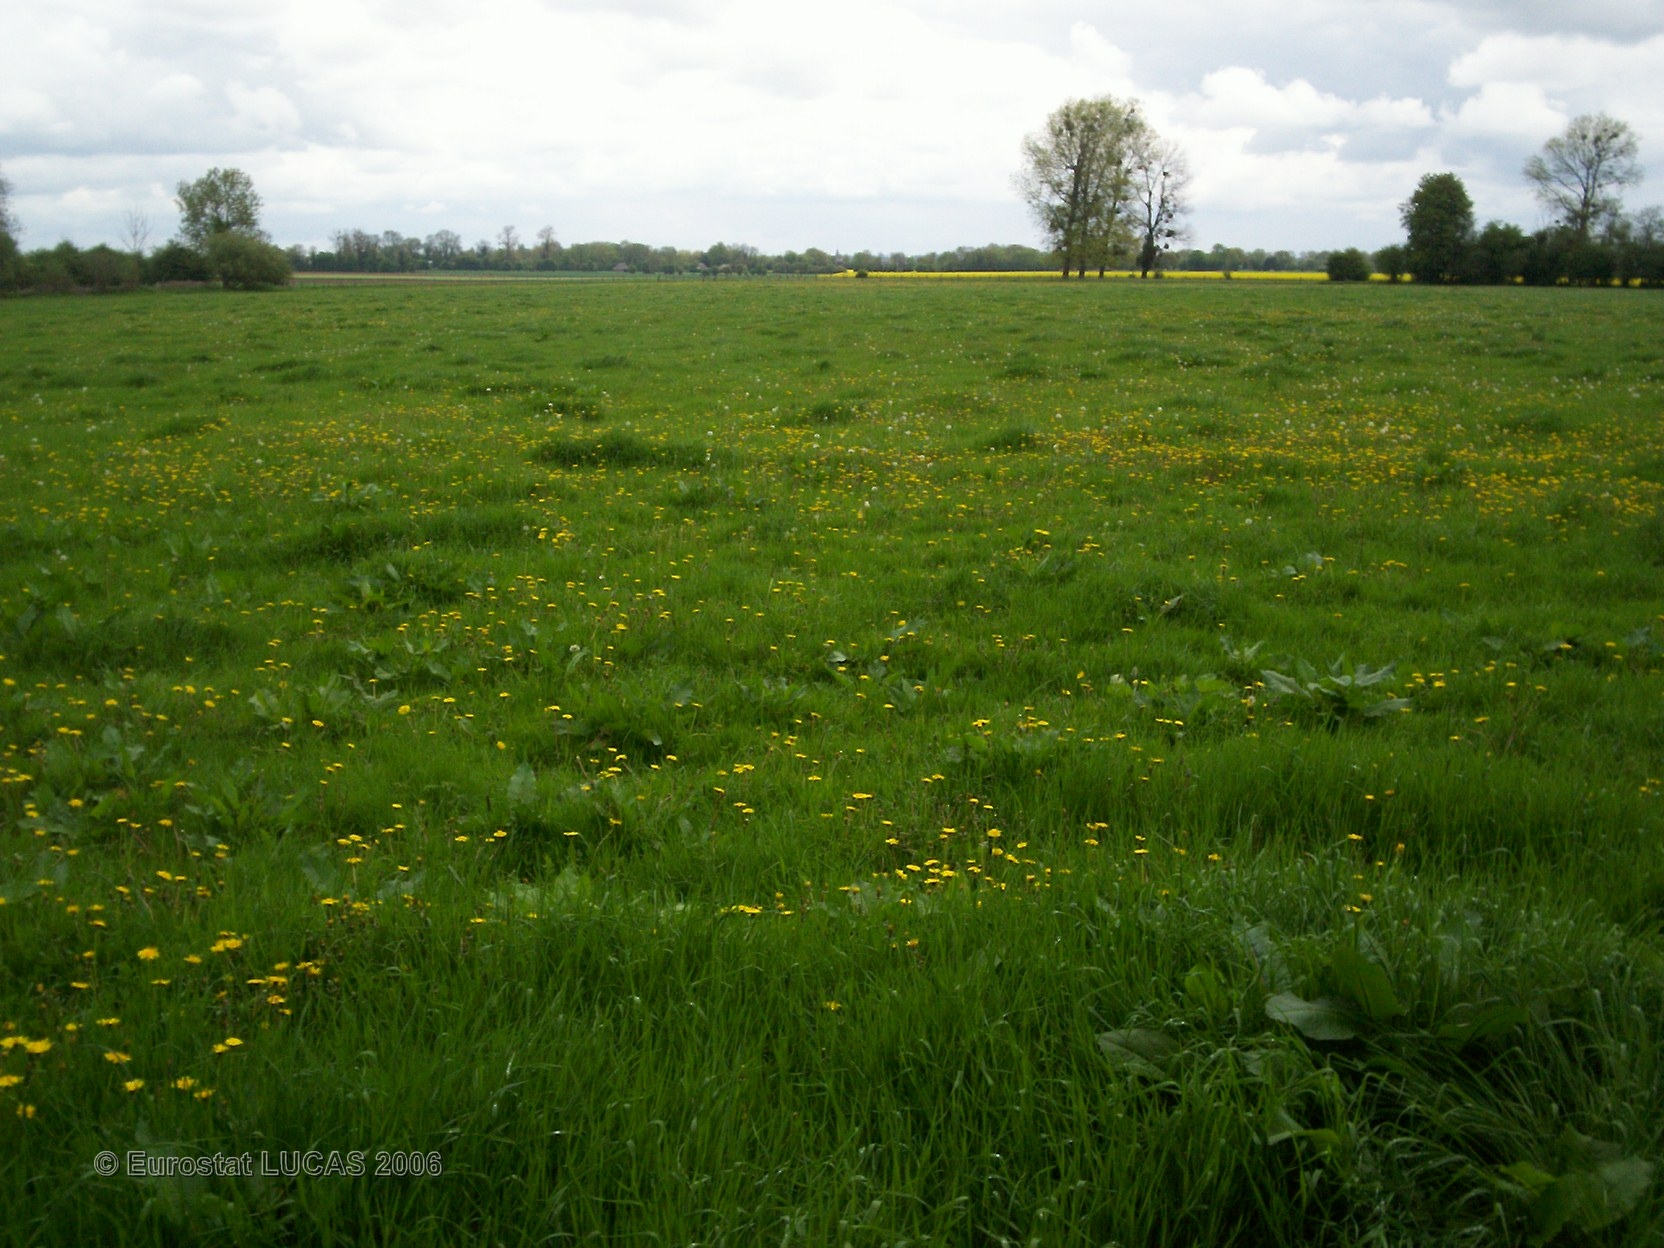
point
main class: Grassland
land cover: Grassland without tree/shrub cover
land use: Agriculture (excluding fallow land and kitchen gardens)
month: May
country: FR
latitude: 49.1172
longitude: 0.5065
